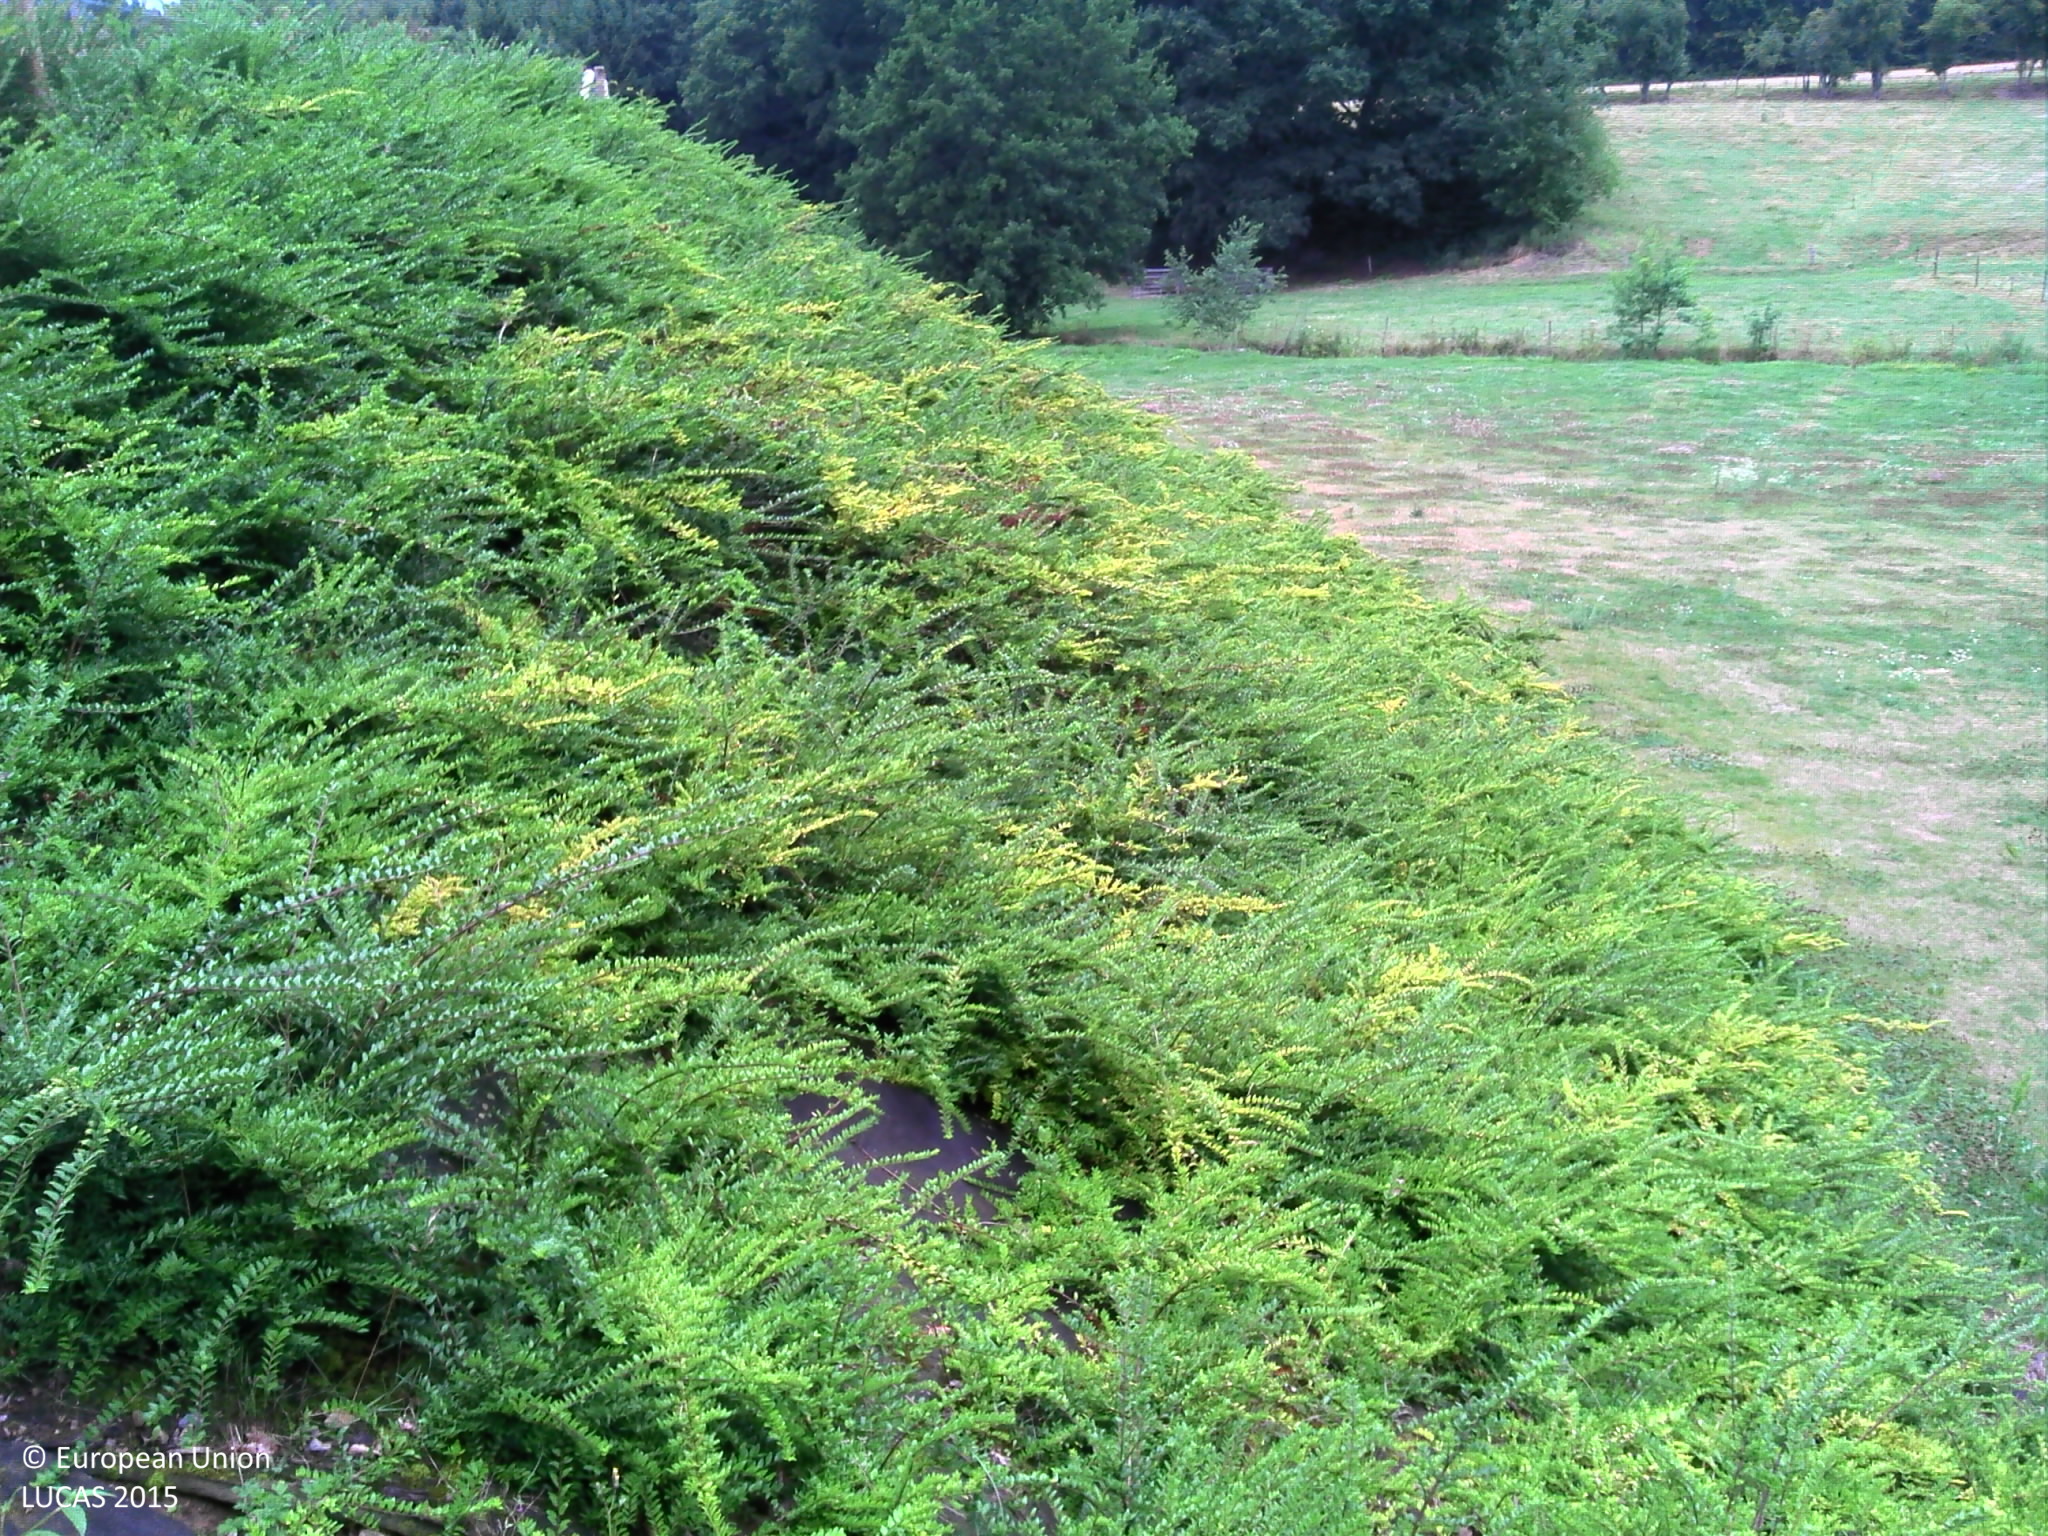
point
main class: Shrubland
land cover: Shrubland without tree cover
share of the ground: > 75 %
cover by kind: shrubs 100 %
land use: Residential
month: July
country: BE
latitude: 49.6388
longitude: 5.8032
